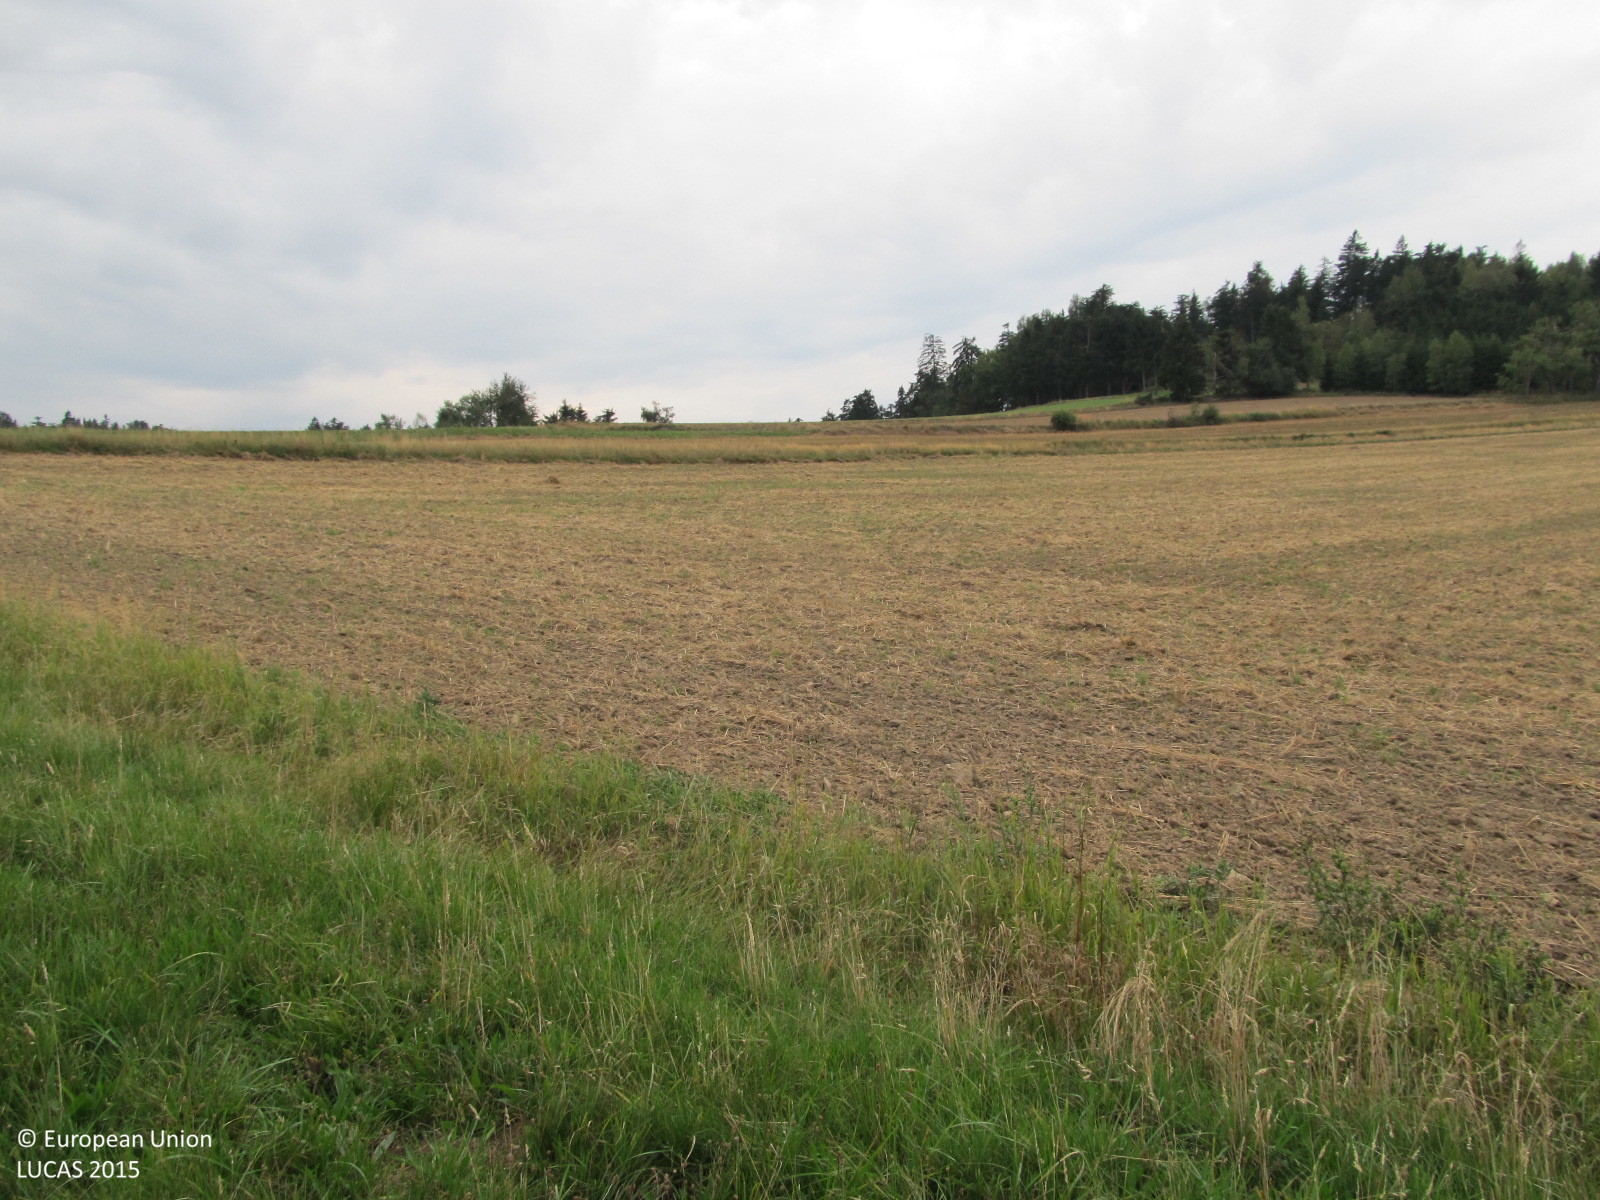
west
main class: Grassland
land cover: Grassland without tree/shrub cover
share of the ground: > 75 %
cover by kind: herbaceous plants 100 %
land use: Agriculture (excluding fallow land and kitchen gardens)
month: September
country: AT
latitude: 48.8506
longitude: 15.3586
